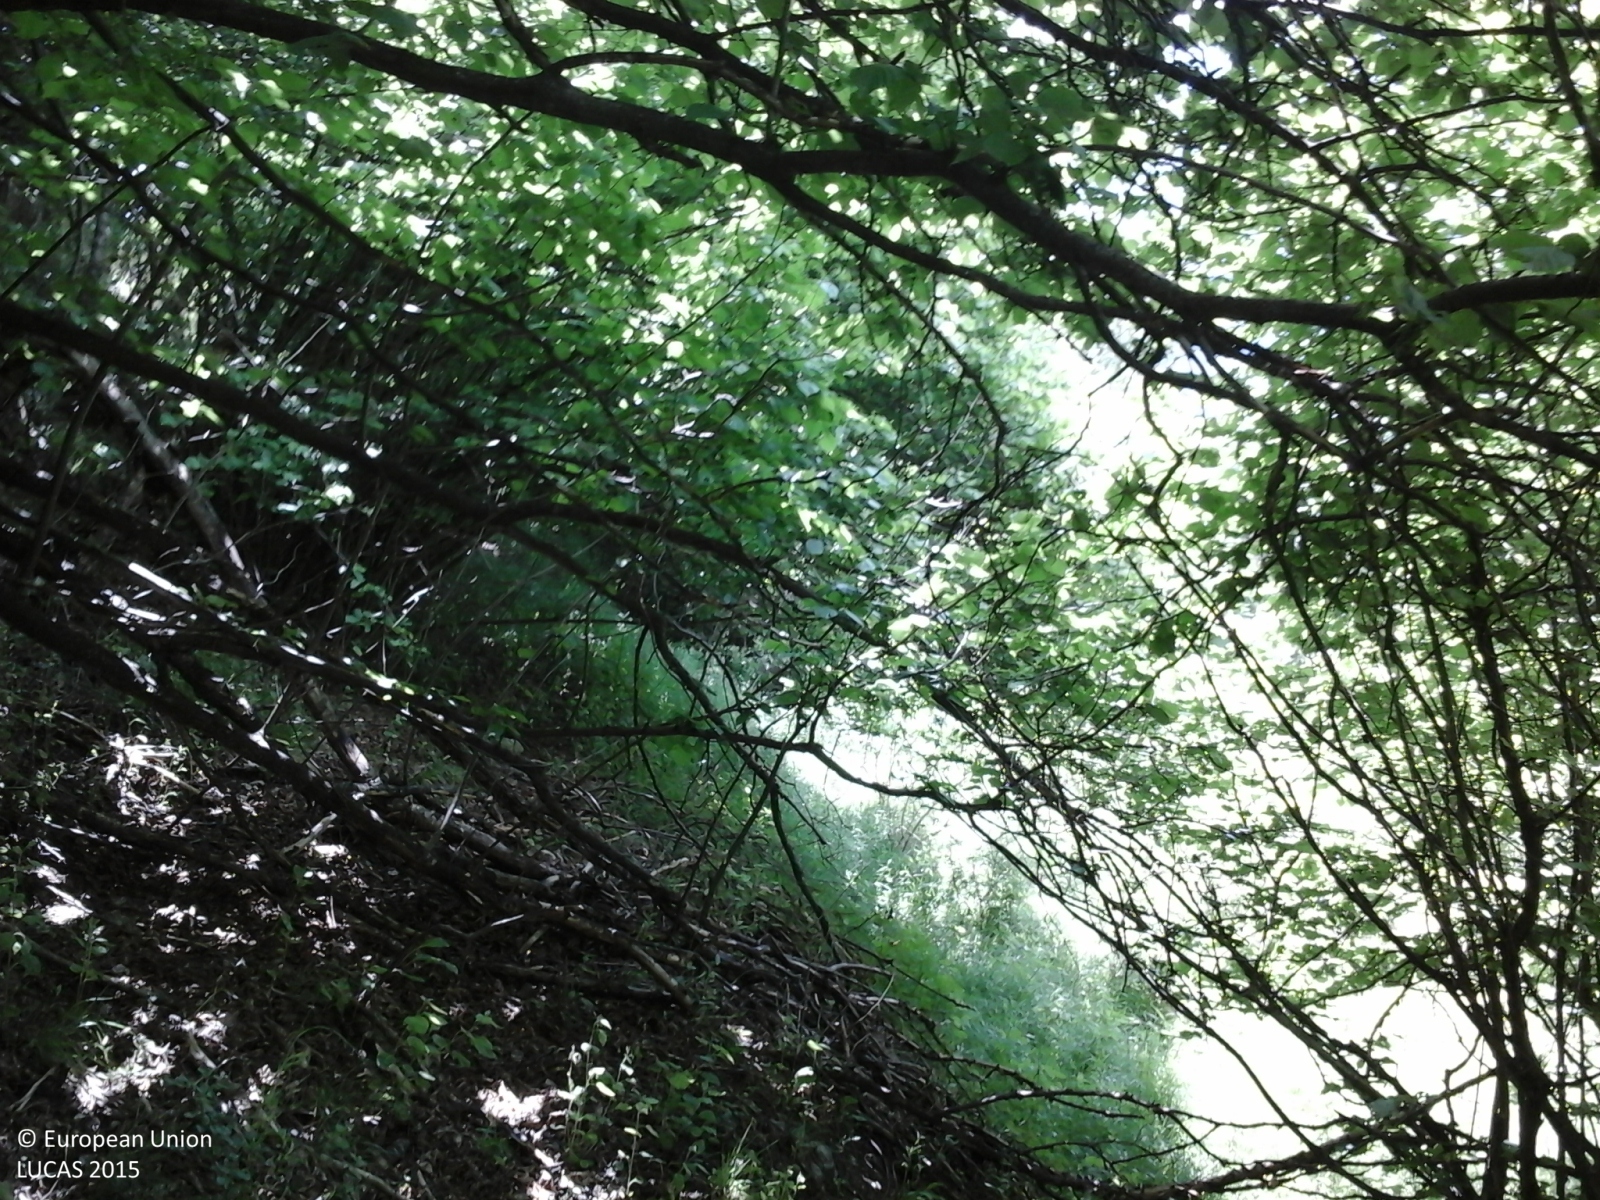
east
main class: Woodland
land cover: Broadleaved woodland
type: thermophilous deciduous forest
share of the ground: > 75 %
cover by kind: broadleaved forest trees 100 %
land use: Semi-natural and natural areas not in use
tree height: > 5 m
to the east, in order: Broadleaved woodland; Grassland without tree/shrub cover; Electric lines; Grassland without tree/shrub cover; Broadleaved woodland; Paved roads, cycling and walking lanes; Other coniferous woodland; Electric lines; Other coniferous woodland
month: June
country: IT
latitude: 46.4587
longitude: 10.3511
